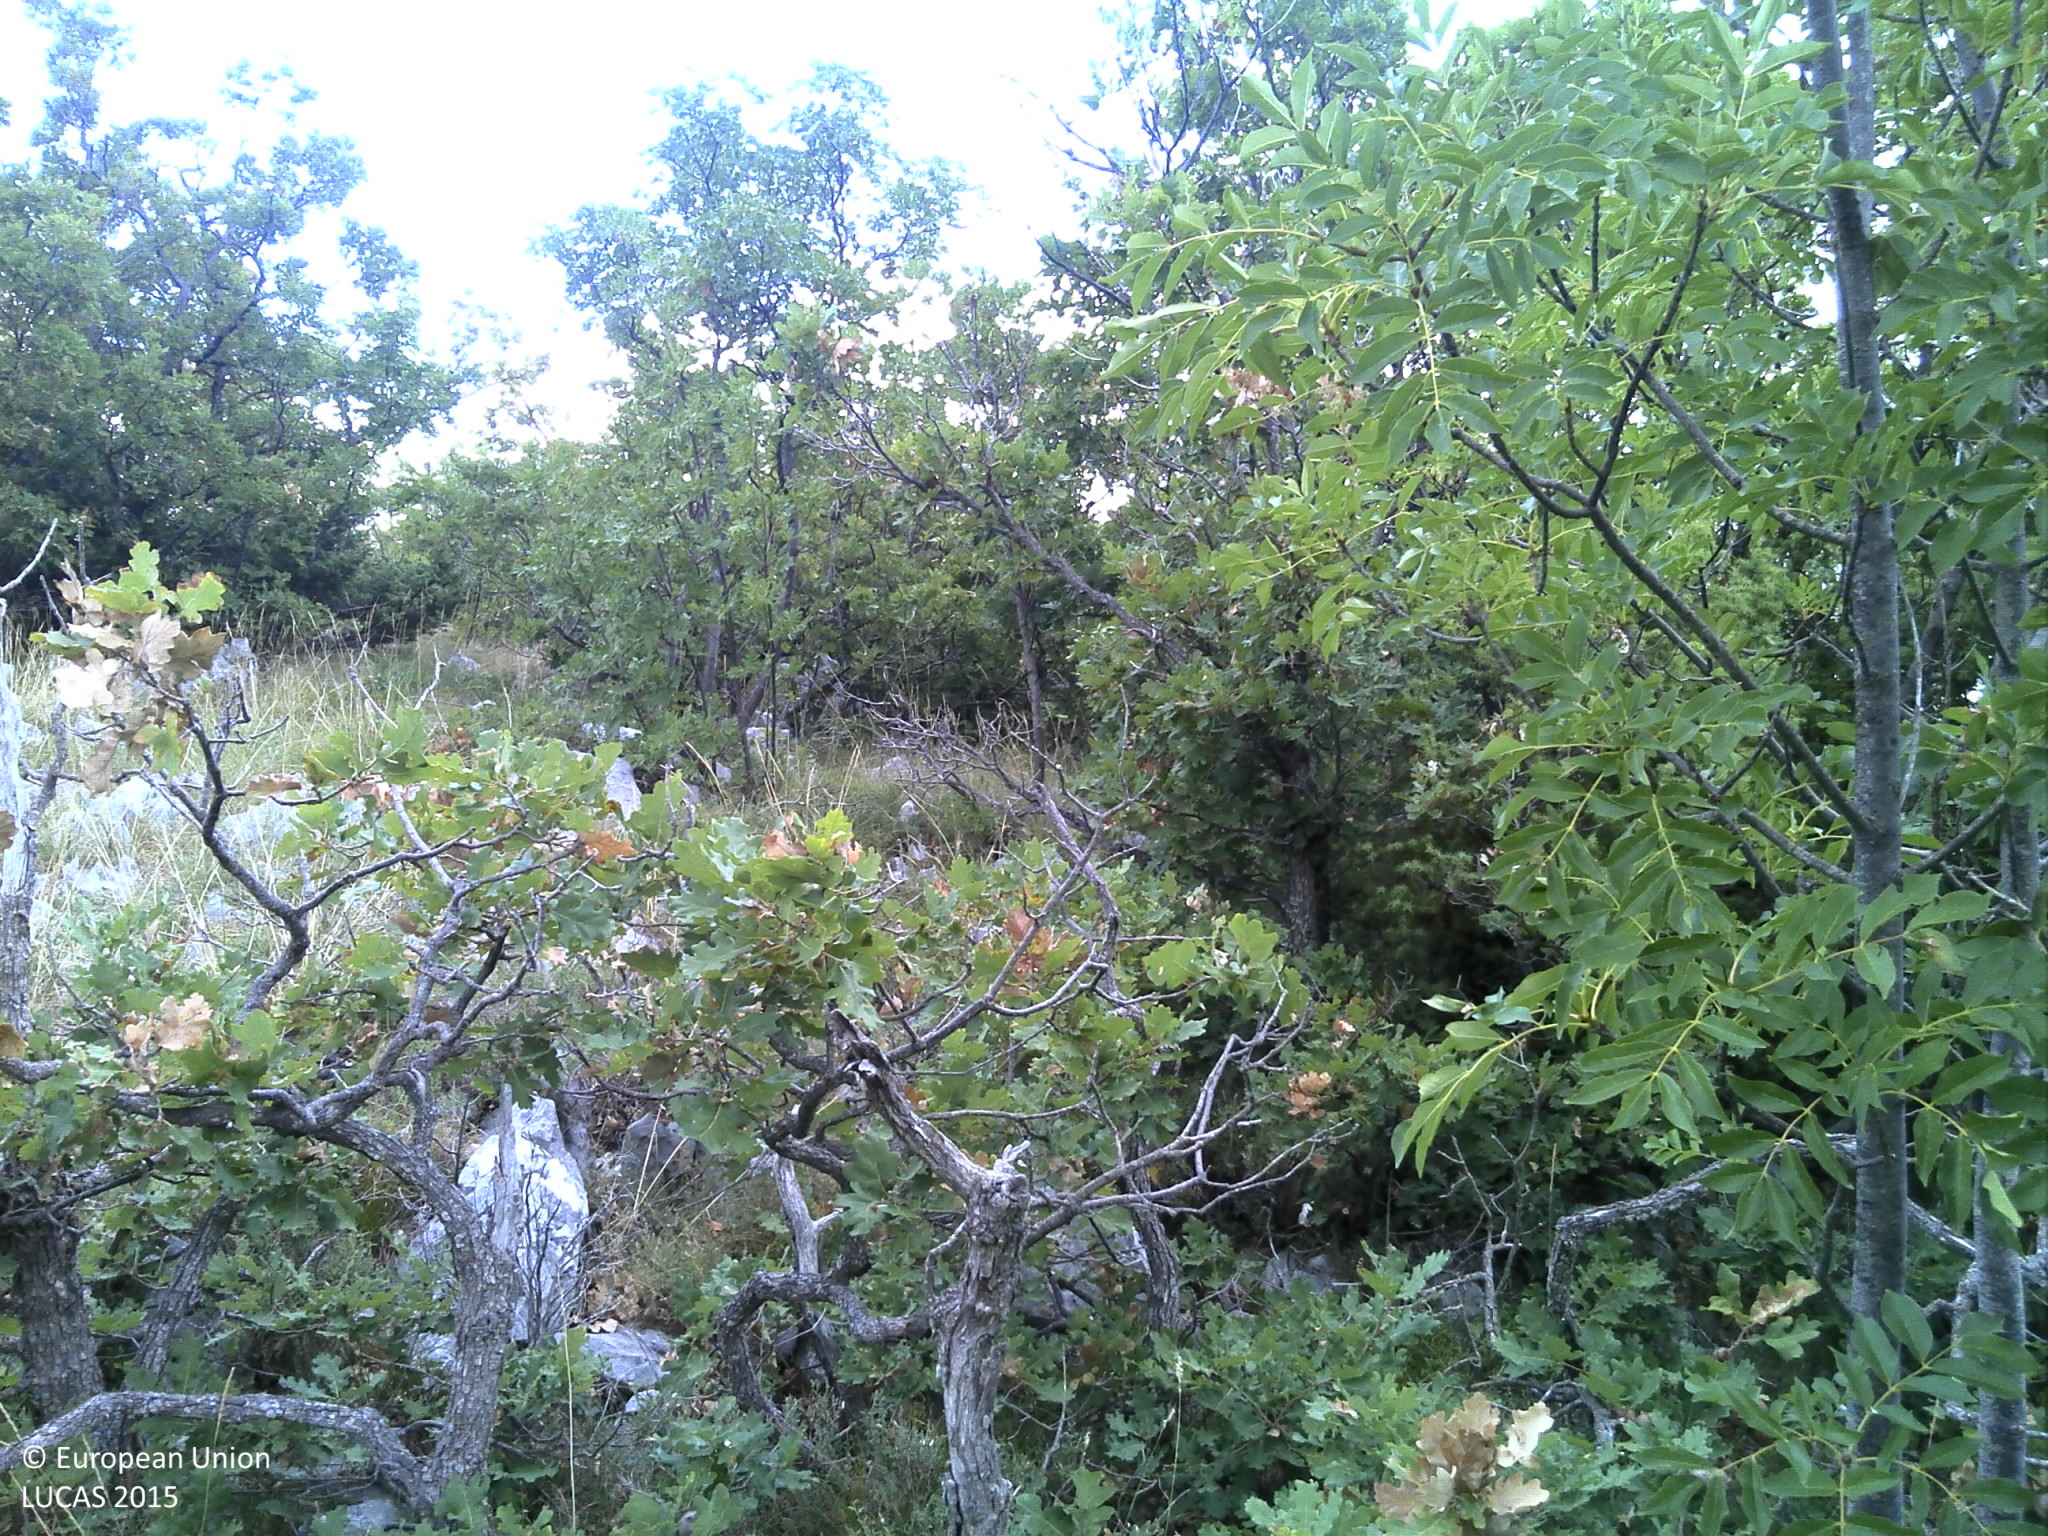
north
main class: Shrubland
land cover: Shrubland with sparse tree cover
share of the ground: > 75 %
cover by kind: shrubs 65 %, herbaceous plants 15 %, unconsolidated bare surface 10 %, broadleaved forest trees 5 %, consolidated bare surface 5 %
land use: Semi-natural and natural areas not in use
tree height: < 5 m
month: August
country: HR
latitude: 43.3016
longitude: 17.2274
